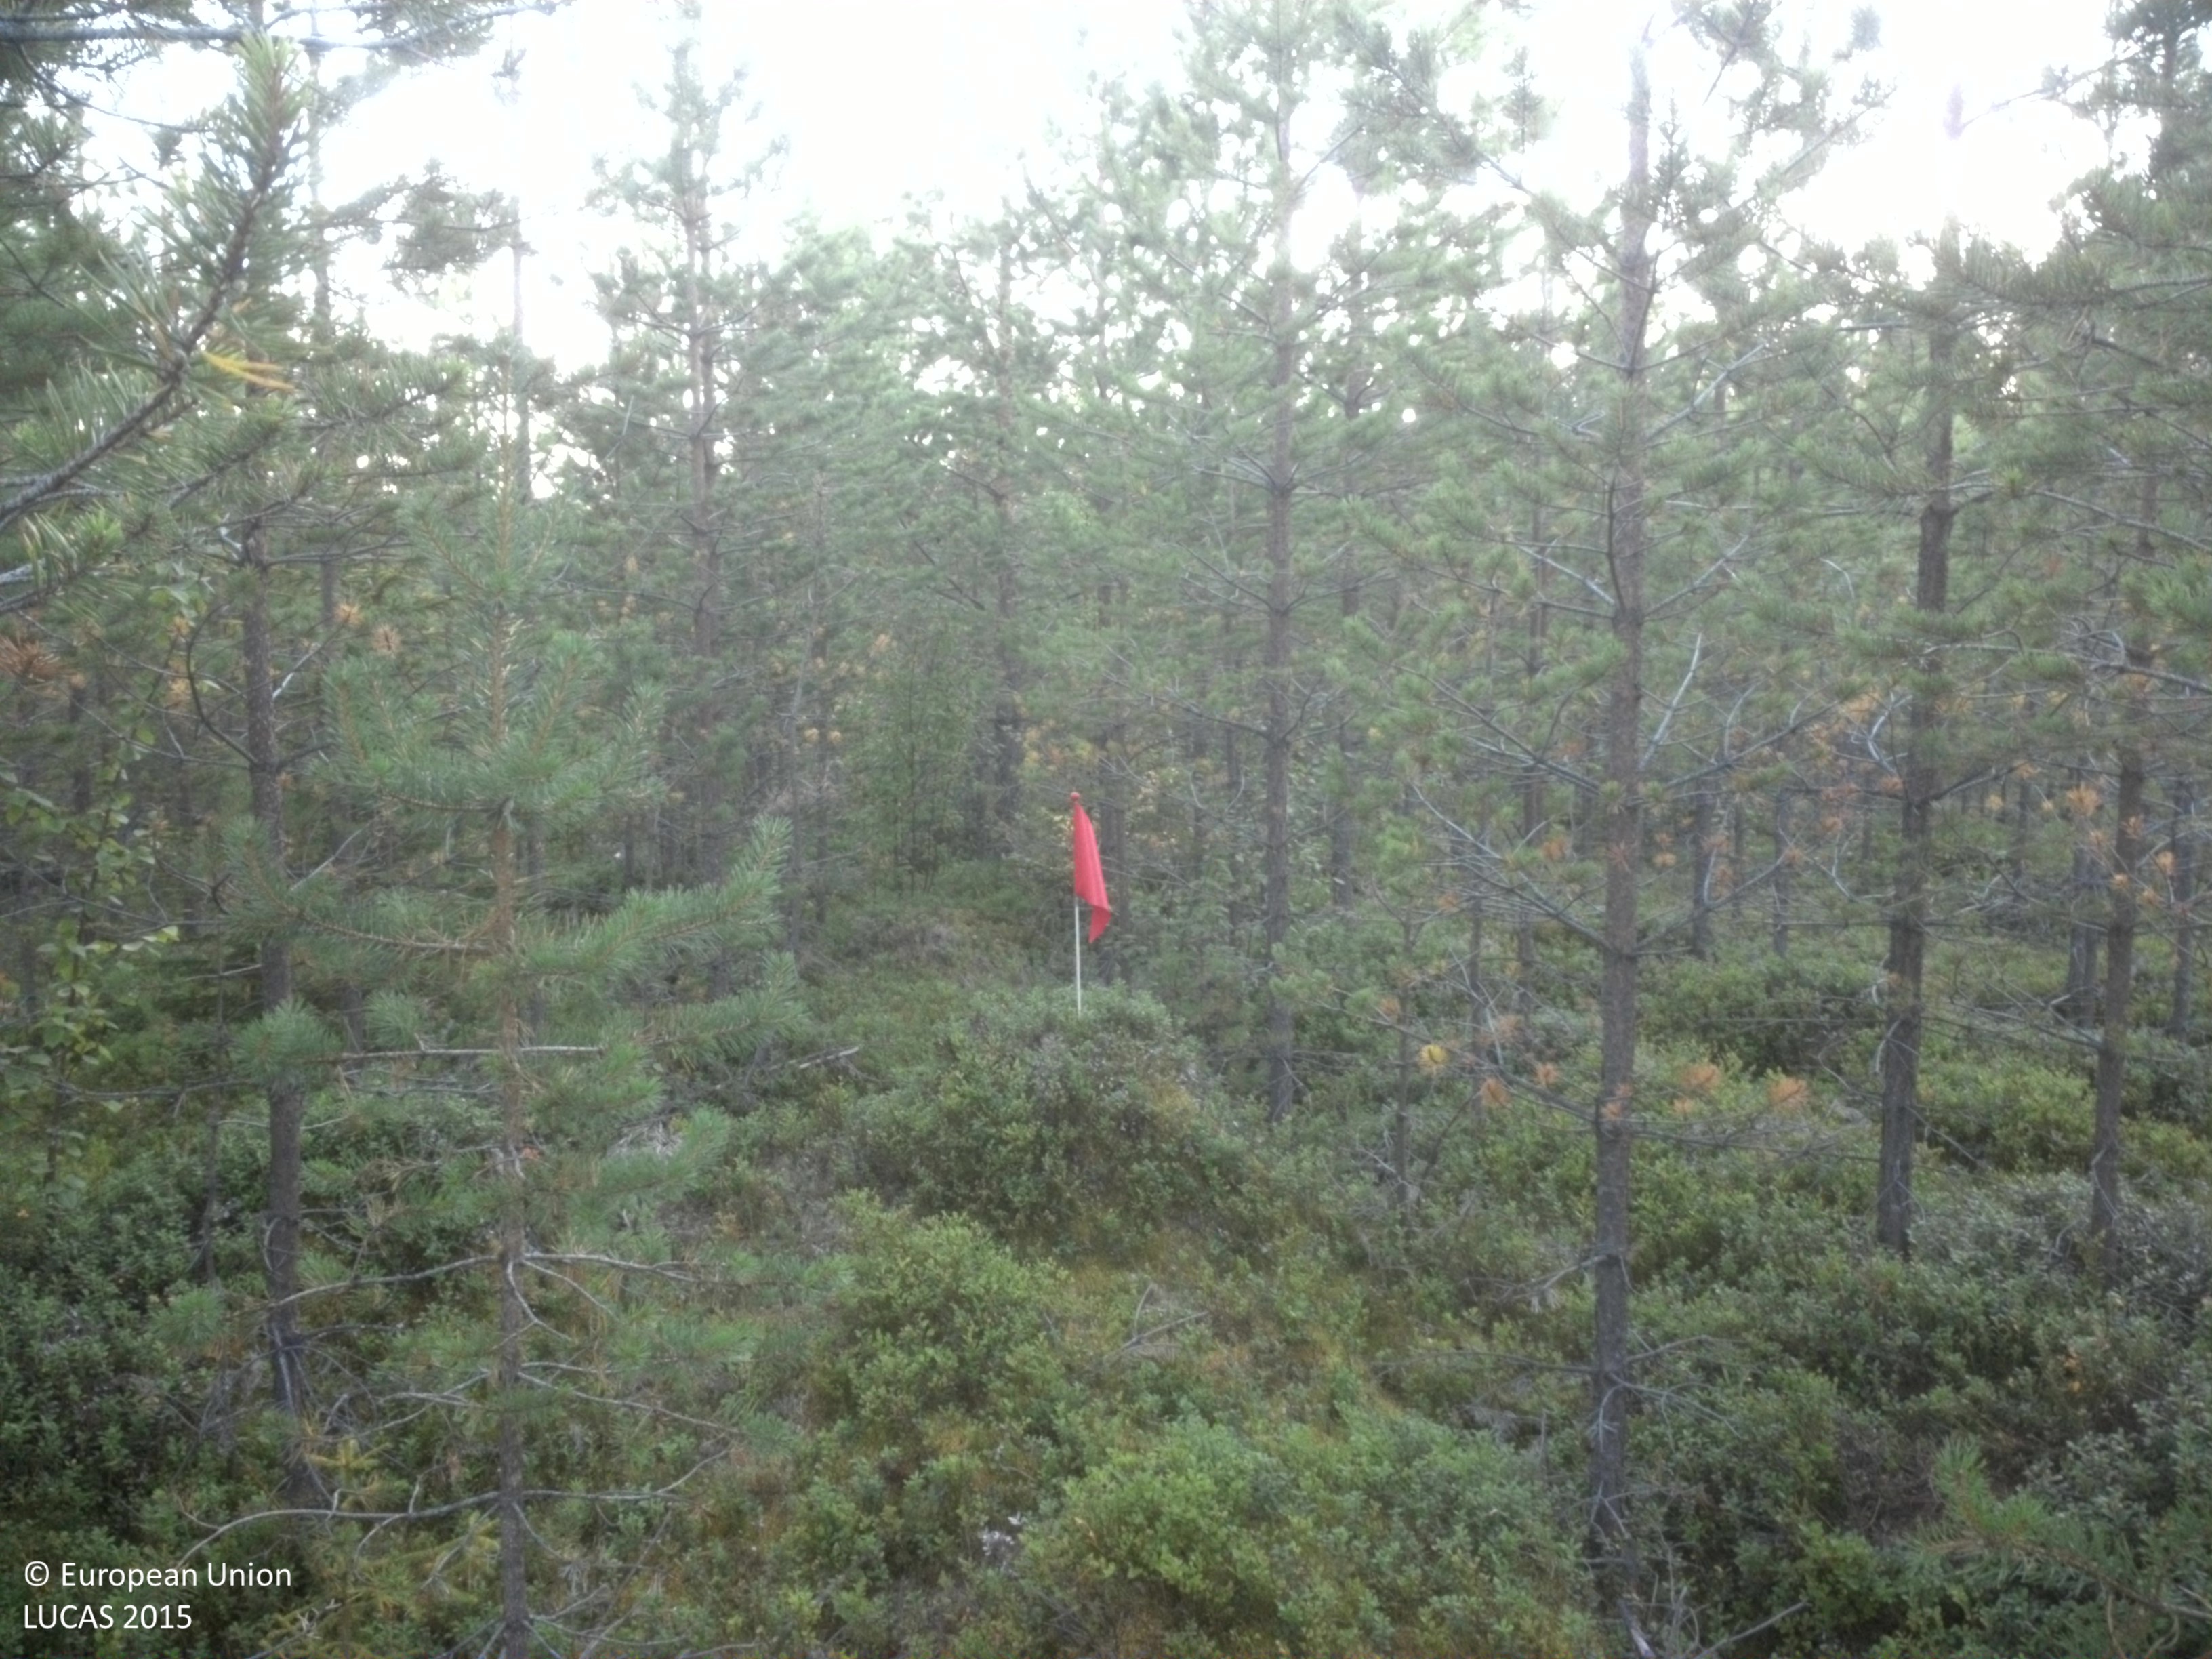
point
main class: Woodland
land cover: Pine dominated coniferous woodland
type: boreal forest
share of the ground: 50 - 75 %
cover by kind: coniferous forest trees 70 %, shrubs 30 %
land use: Forestry
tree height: < 5 m
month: August
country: SE
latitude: 64.6391
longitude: 18.9032
